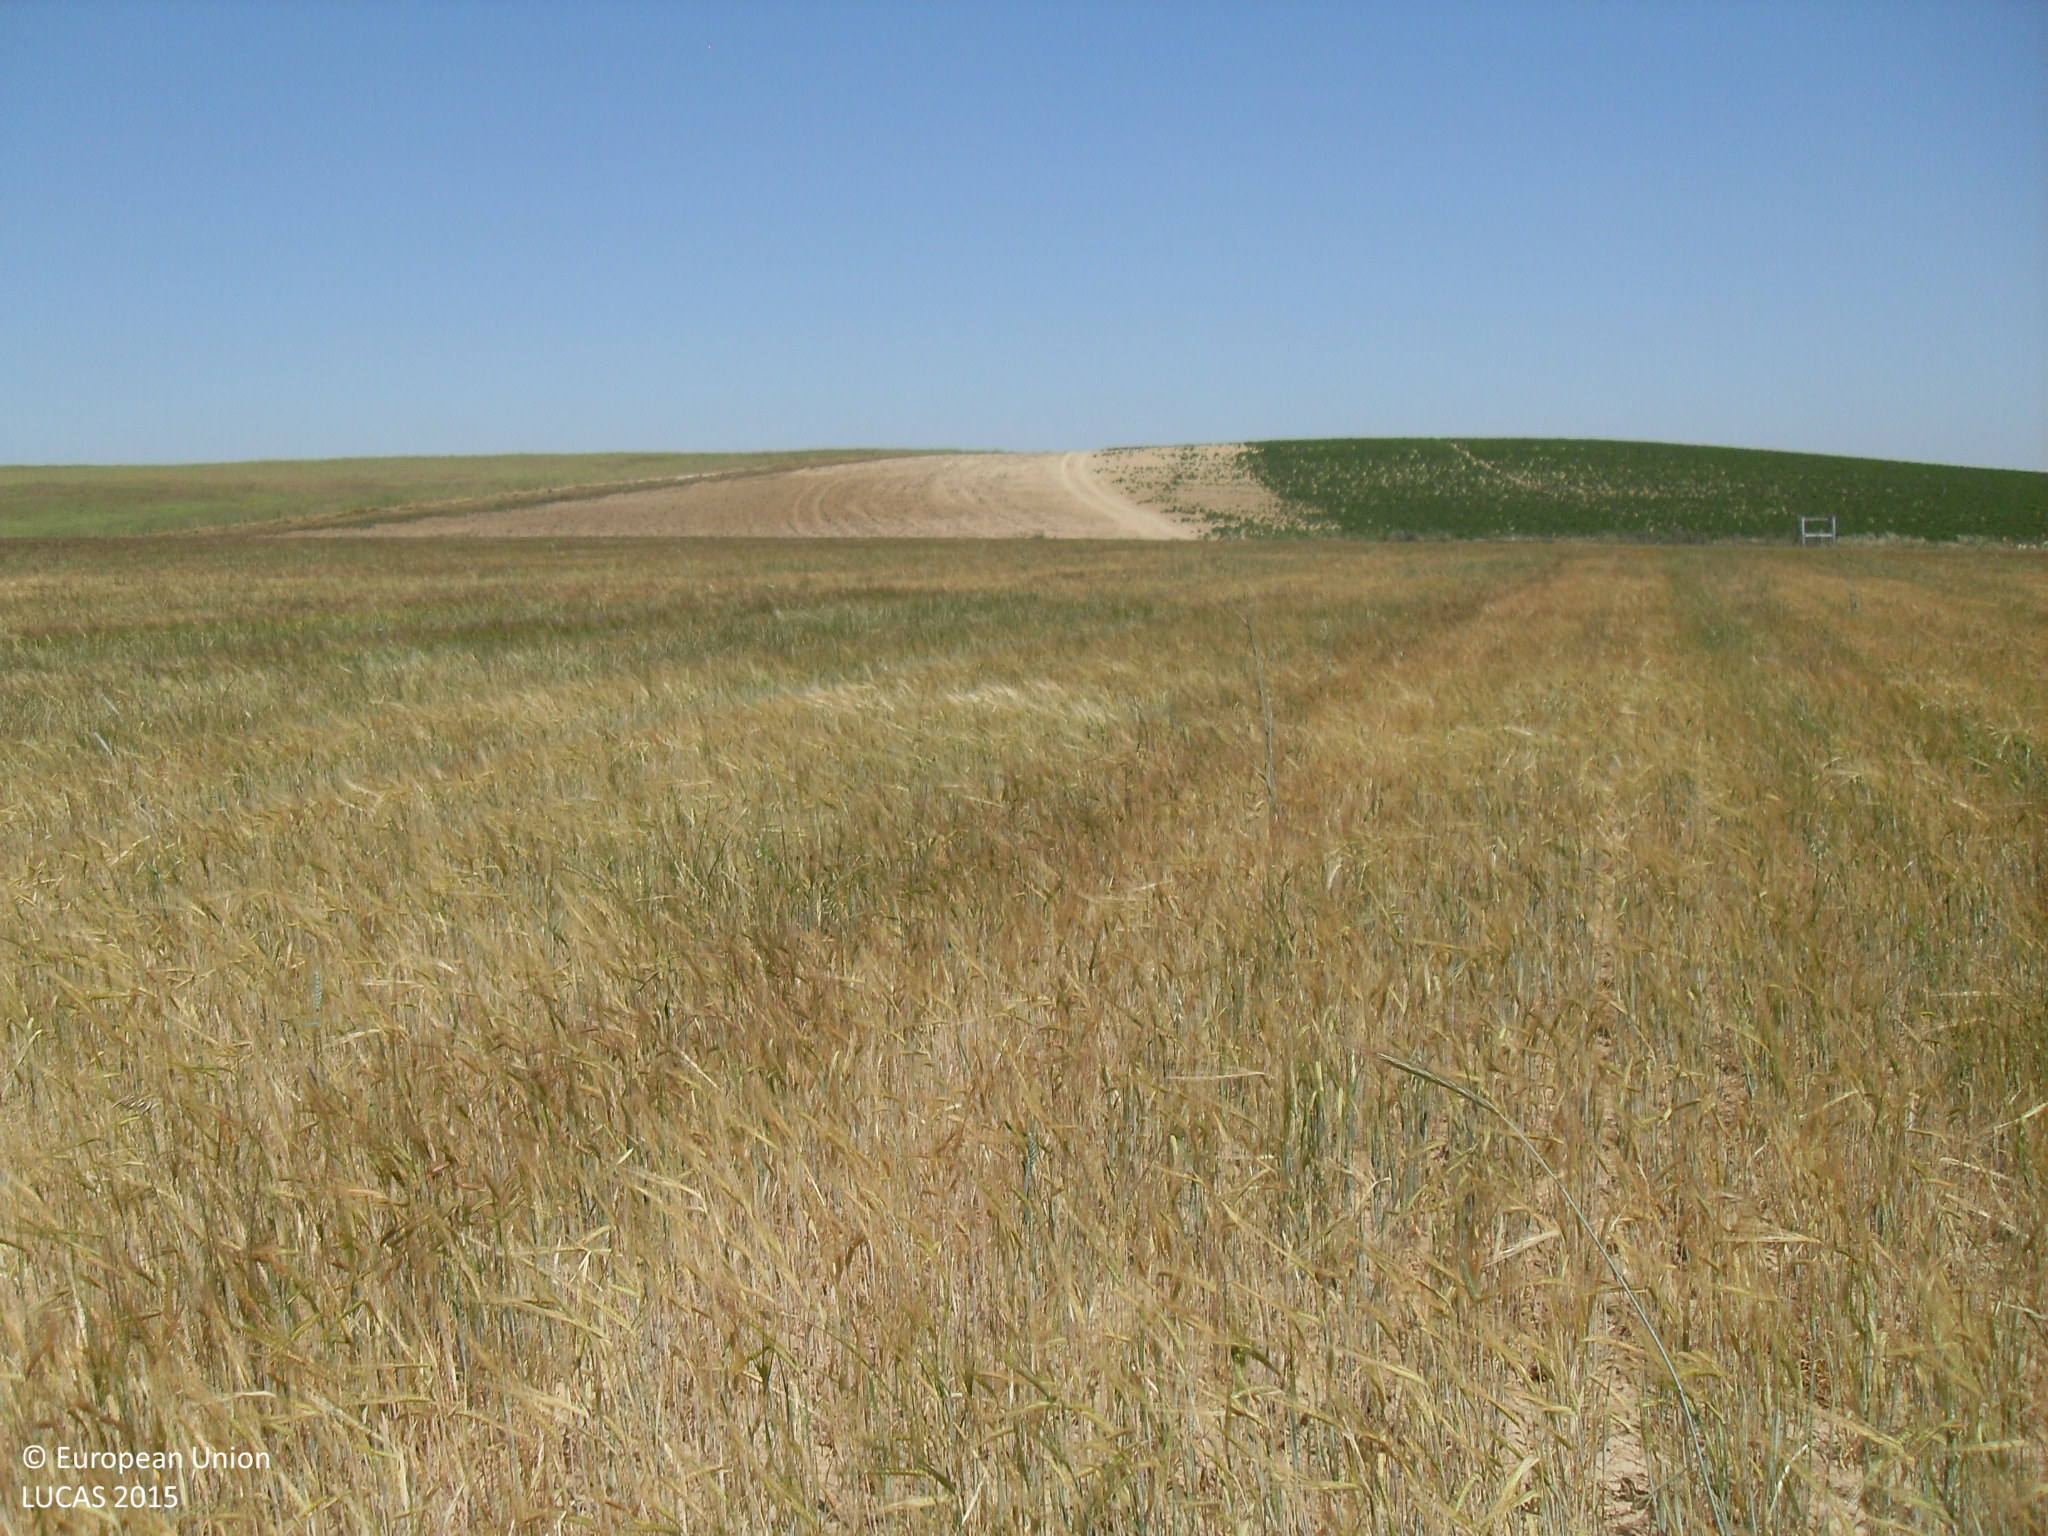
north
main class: Cropland
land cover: Barley
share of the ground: > 75 %
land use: Agriculture (excluding fallow land and kitchen gardens)
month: May
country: ES
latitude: 41.1304
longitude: -5.2111
